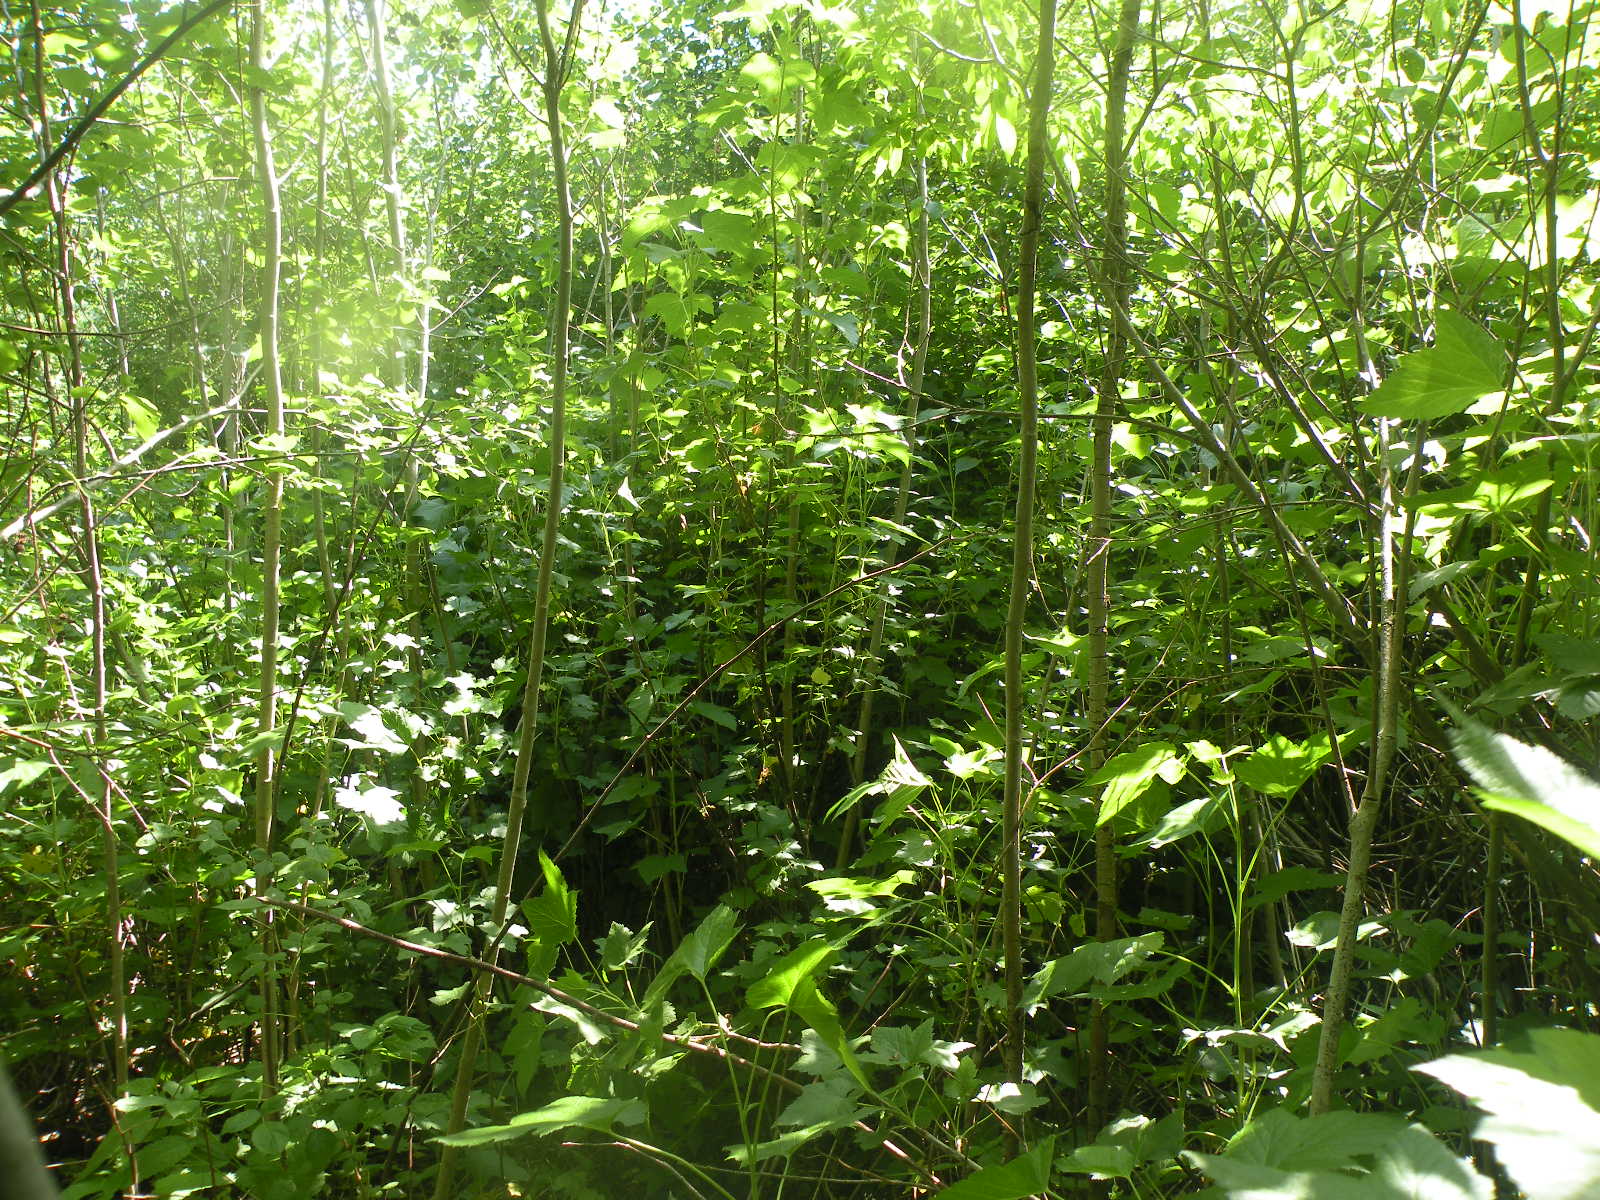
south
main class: Woodland
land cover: Broadleaved woodland
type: non-riverine alder, birch or aspen forest
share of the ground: > 75 %
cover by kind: broadleaved forest trees 95 %, herbaceous plants 5 %
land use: Forestry
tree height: < 5 m
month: June
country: LV
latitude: 56.1170
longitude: 26.8052
